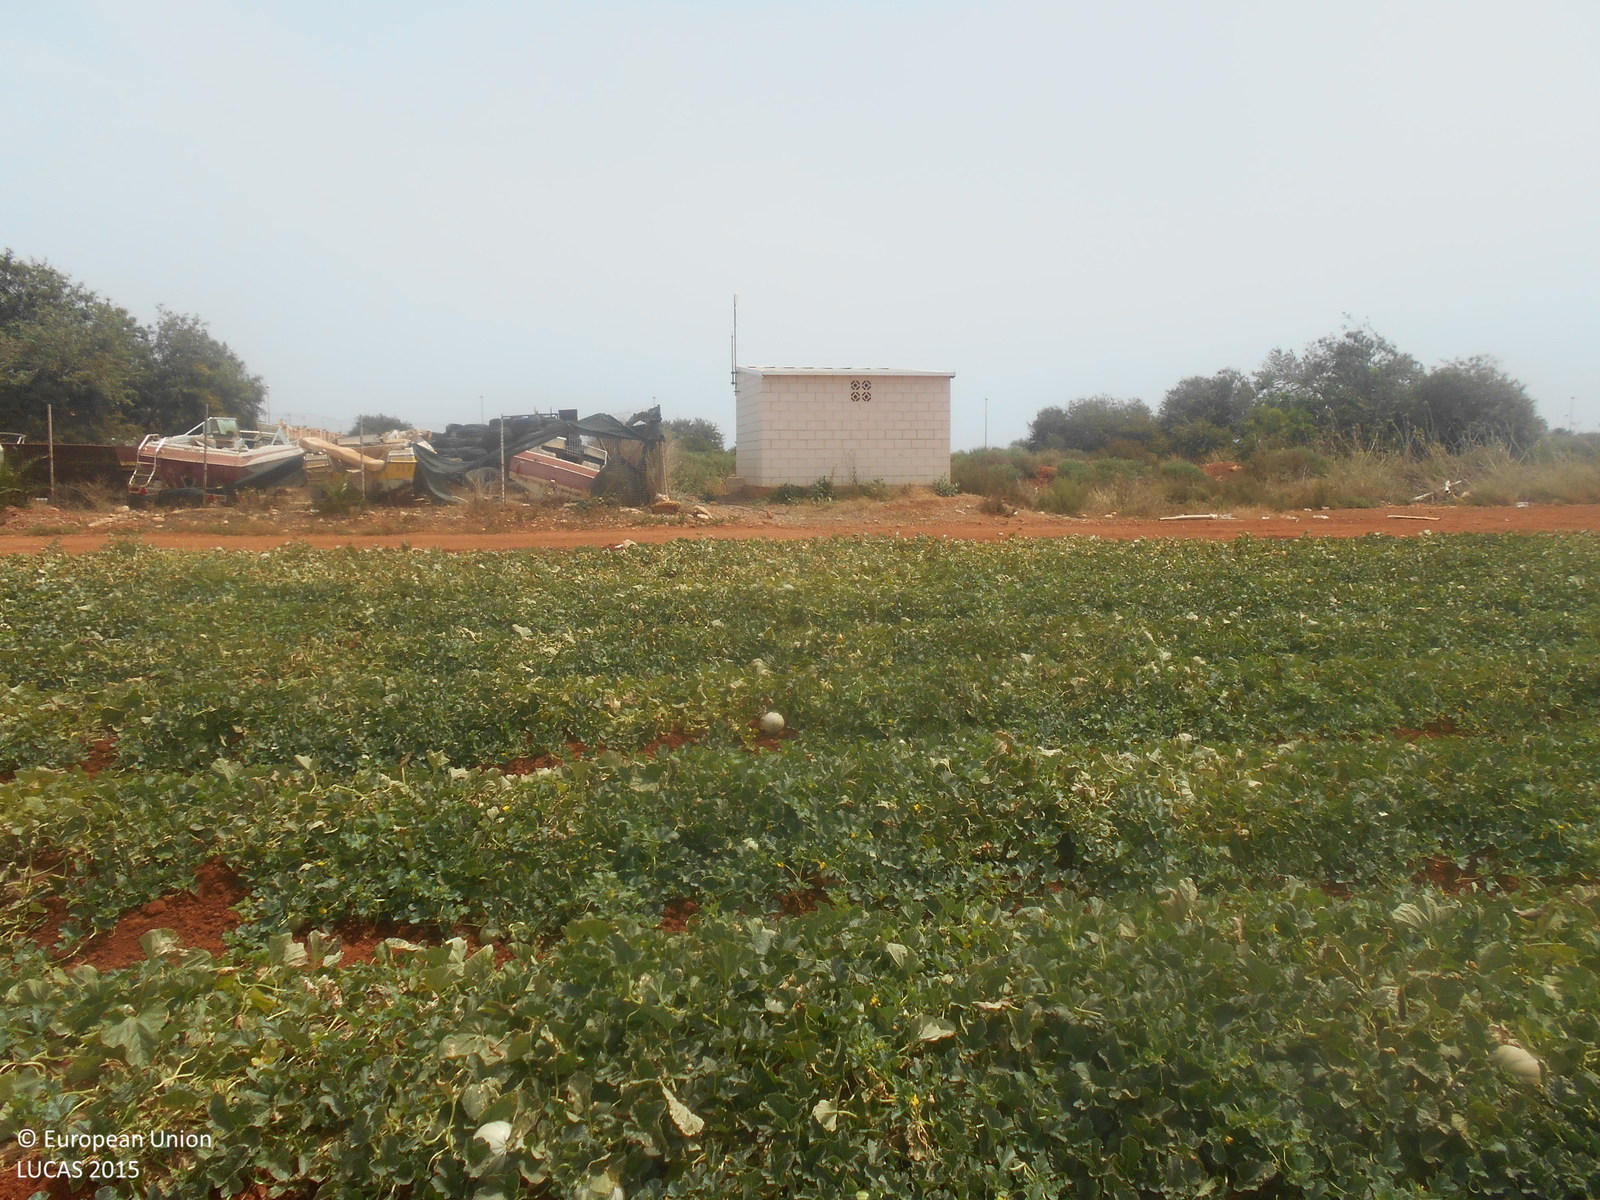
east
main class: Cropland
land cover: Other fresh vegetables
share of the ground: 50 - 75 %
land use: Agriculture (excluding fallow land and kitchen gardens)
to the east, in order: Other fresh vegetables; Tracks; Artificial constructions in urban areas; Grassland without tree/shrub cover; Grassland with sparse tree/shrub cover; Shrubland without tree cover; Artificial constructions; Paved roads, cycling and walking lanes; Artificial constructions; Shrubland without tree cover
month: May
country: ES
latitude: 37.6757
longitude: -0.8294
